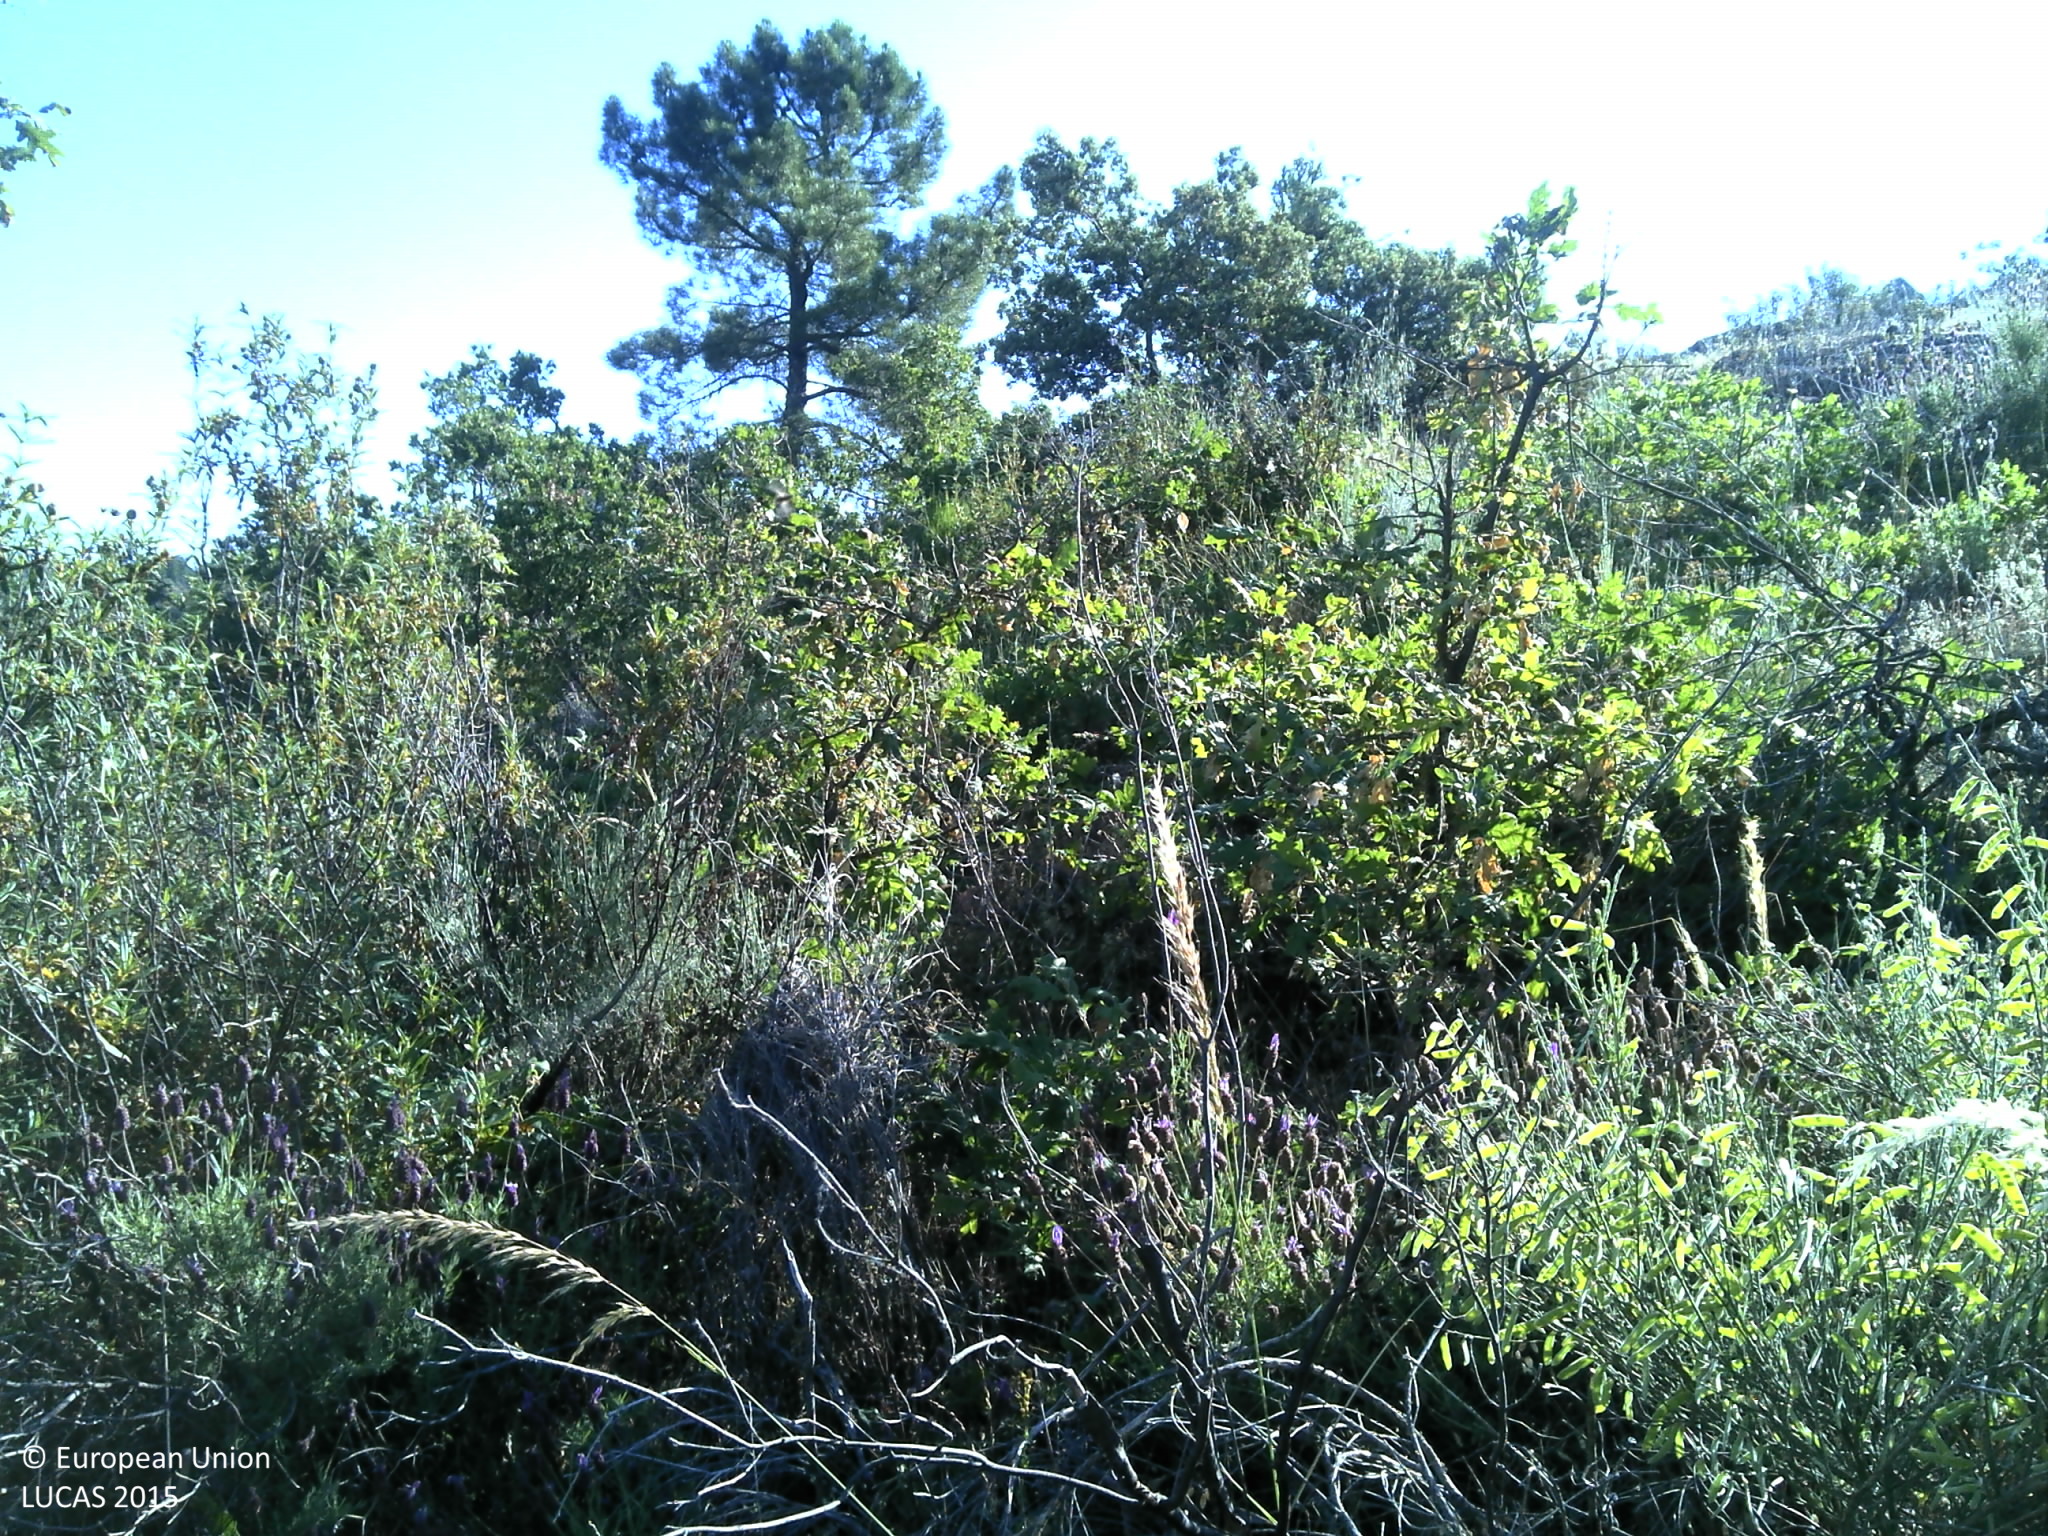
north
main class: Woodland
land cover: Other coniferous woodland
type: coniferous forest of the mediterranean region
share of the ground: 10 - 25 %
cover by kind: shrubs 70 %, coniferous forest trees 10 %, herbaceous plants 10 %, unconsolidated bare surface 10 %
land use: Forestry
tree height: < 5 m
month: May
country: PT
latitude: 41.5937
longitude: -6.5529
